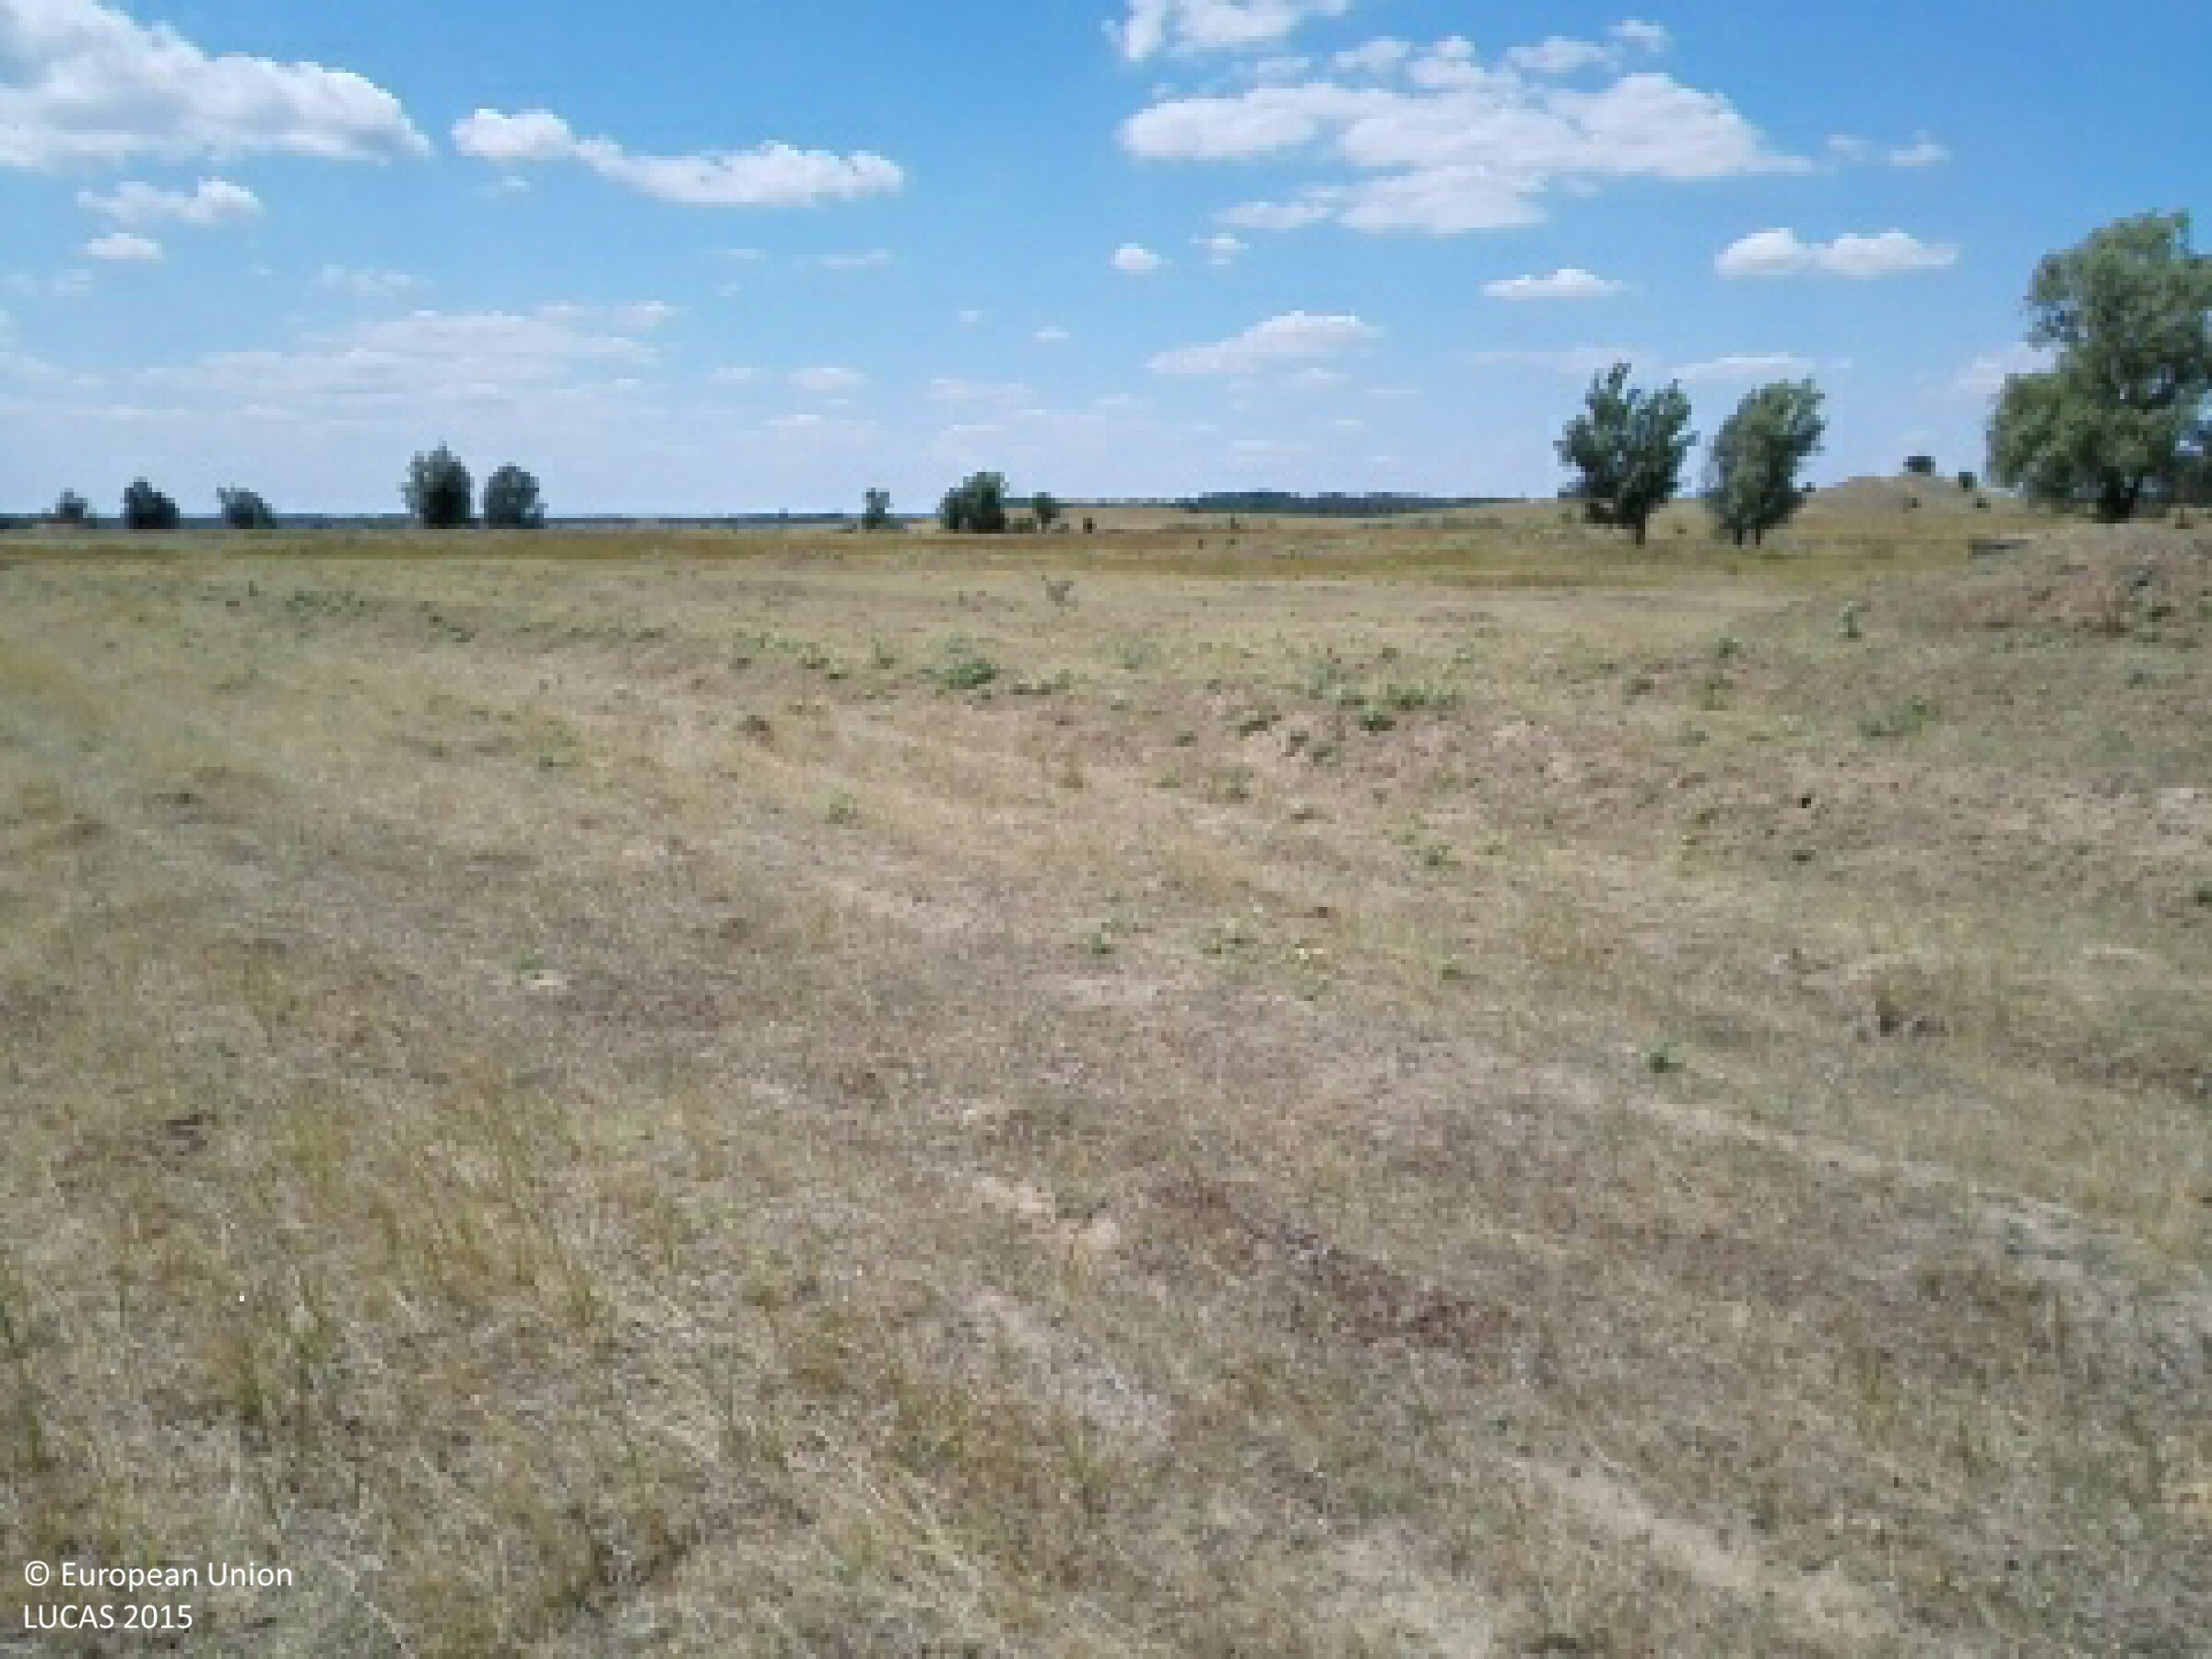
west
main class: Grassland
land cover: Grassland without tree/shrub cover
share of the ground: > 75 %
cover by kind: herbaceous plants 100 %
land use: Agriculture (excluding fallow land and kitchen gardens)
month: July
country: HU
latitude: 47.7007
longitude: 21.7607
